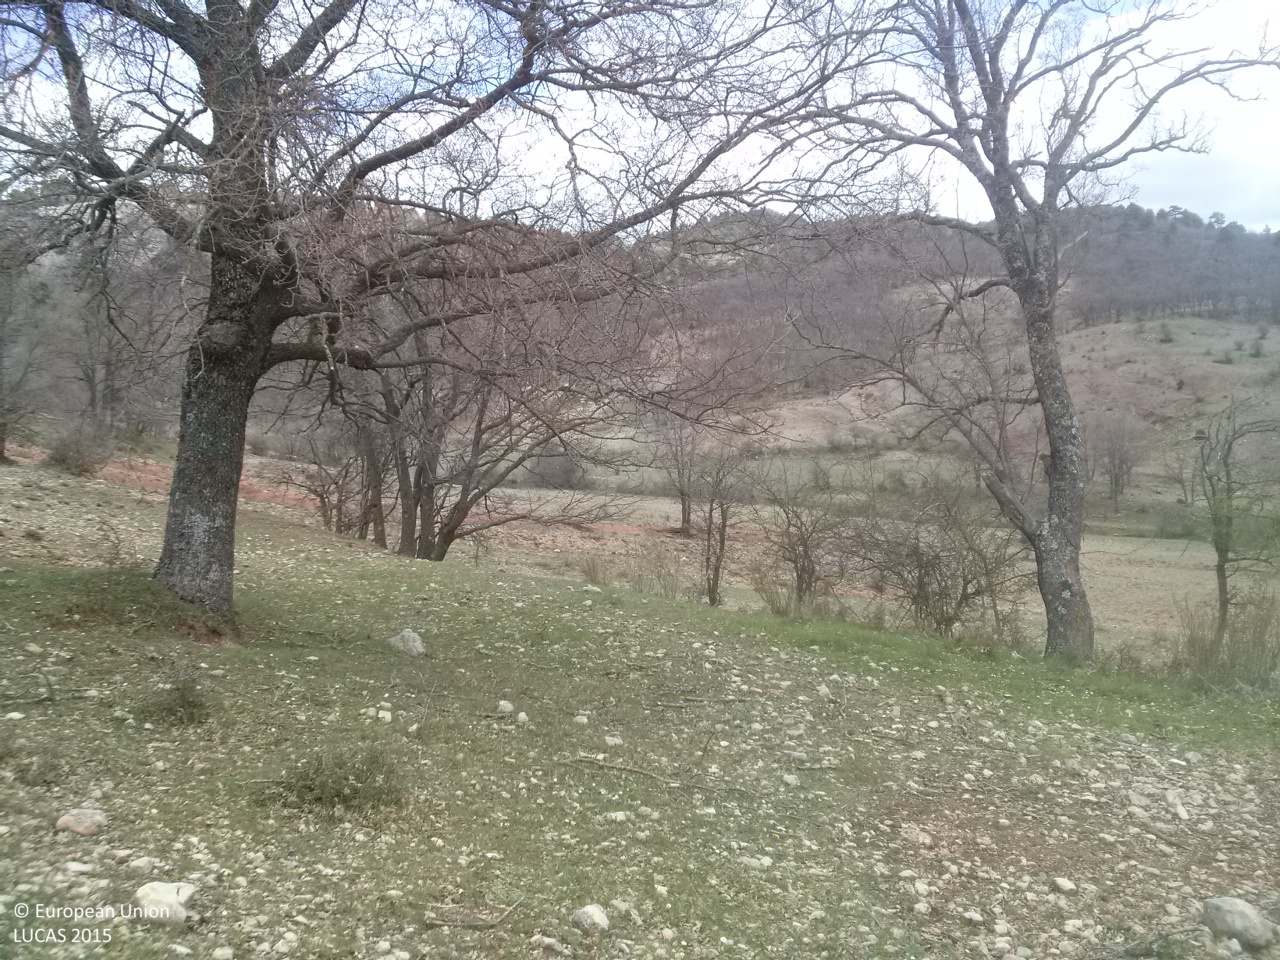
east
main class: Grassland
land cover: Grassland with sparse tree/shrub cover
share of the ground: 50 - 75 %
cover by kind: herbaceous plants 65 %, unconsolidated bare surface 30 %, broadleaved forest trees 5 %
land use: Agriculture (excluding fallow land and kitchen gardens)
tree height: > 5 m
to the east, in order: Grassland with sparse tree/shrub cover; Broadleaved woodland; Grassland without tree/shrub cover; Other bare soil; Single bushes/trees; Grassland without tree/shrub cover; Other bare soil; Grassland without tree/shrub cover; Abandoned hedges; Rivers and streams; Abandoned hedges; Grassland without tree/shrub cover; Single bushes/trees; Grassland without tree/shrub cover
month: April
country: ES
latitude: 40.3352
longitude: -1.8224
